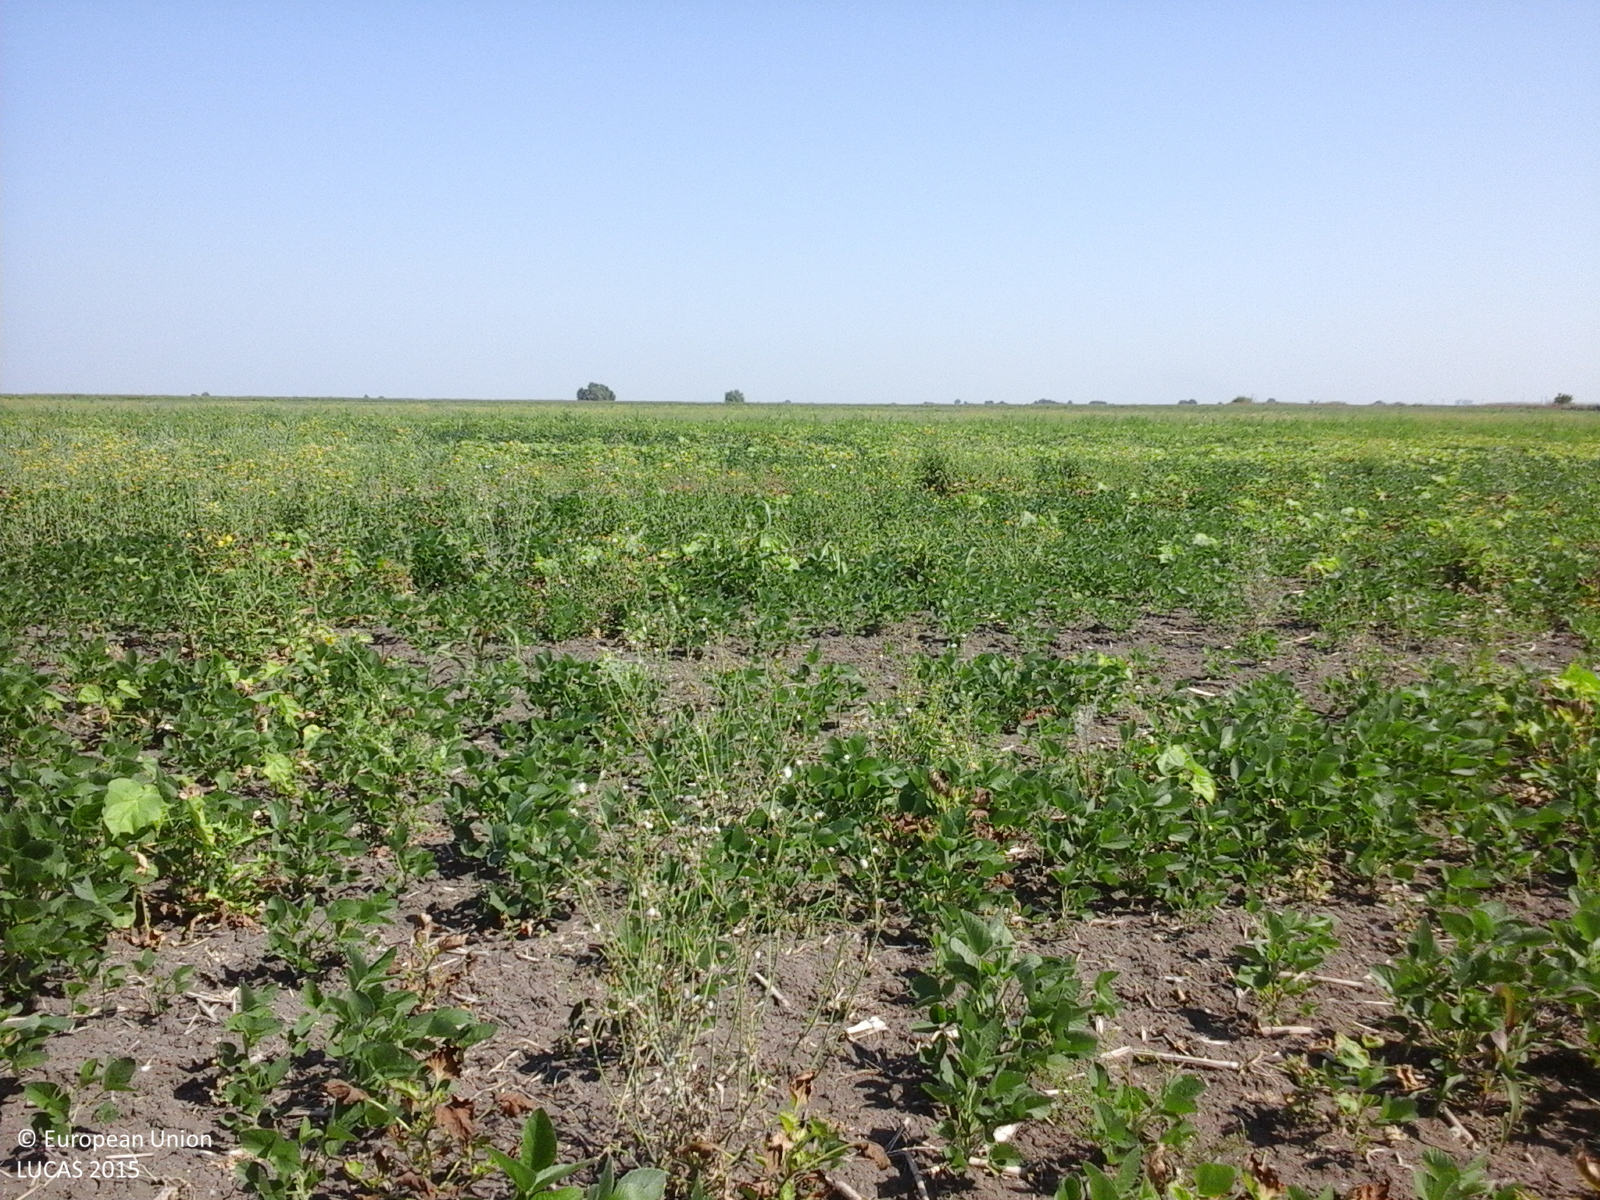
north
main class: Cropland
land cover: Soya
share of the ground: 50 - 75 %
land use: Agriculture (excluding fallow land and kitchen gardens)
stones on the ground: < 10 %
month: July
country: RO
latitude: 44.1452
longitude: 27.2461
